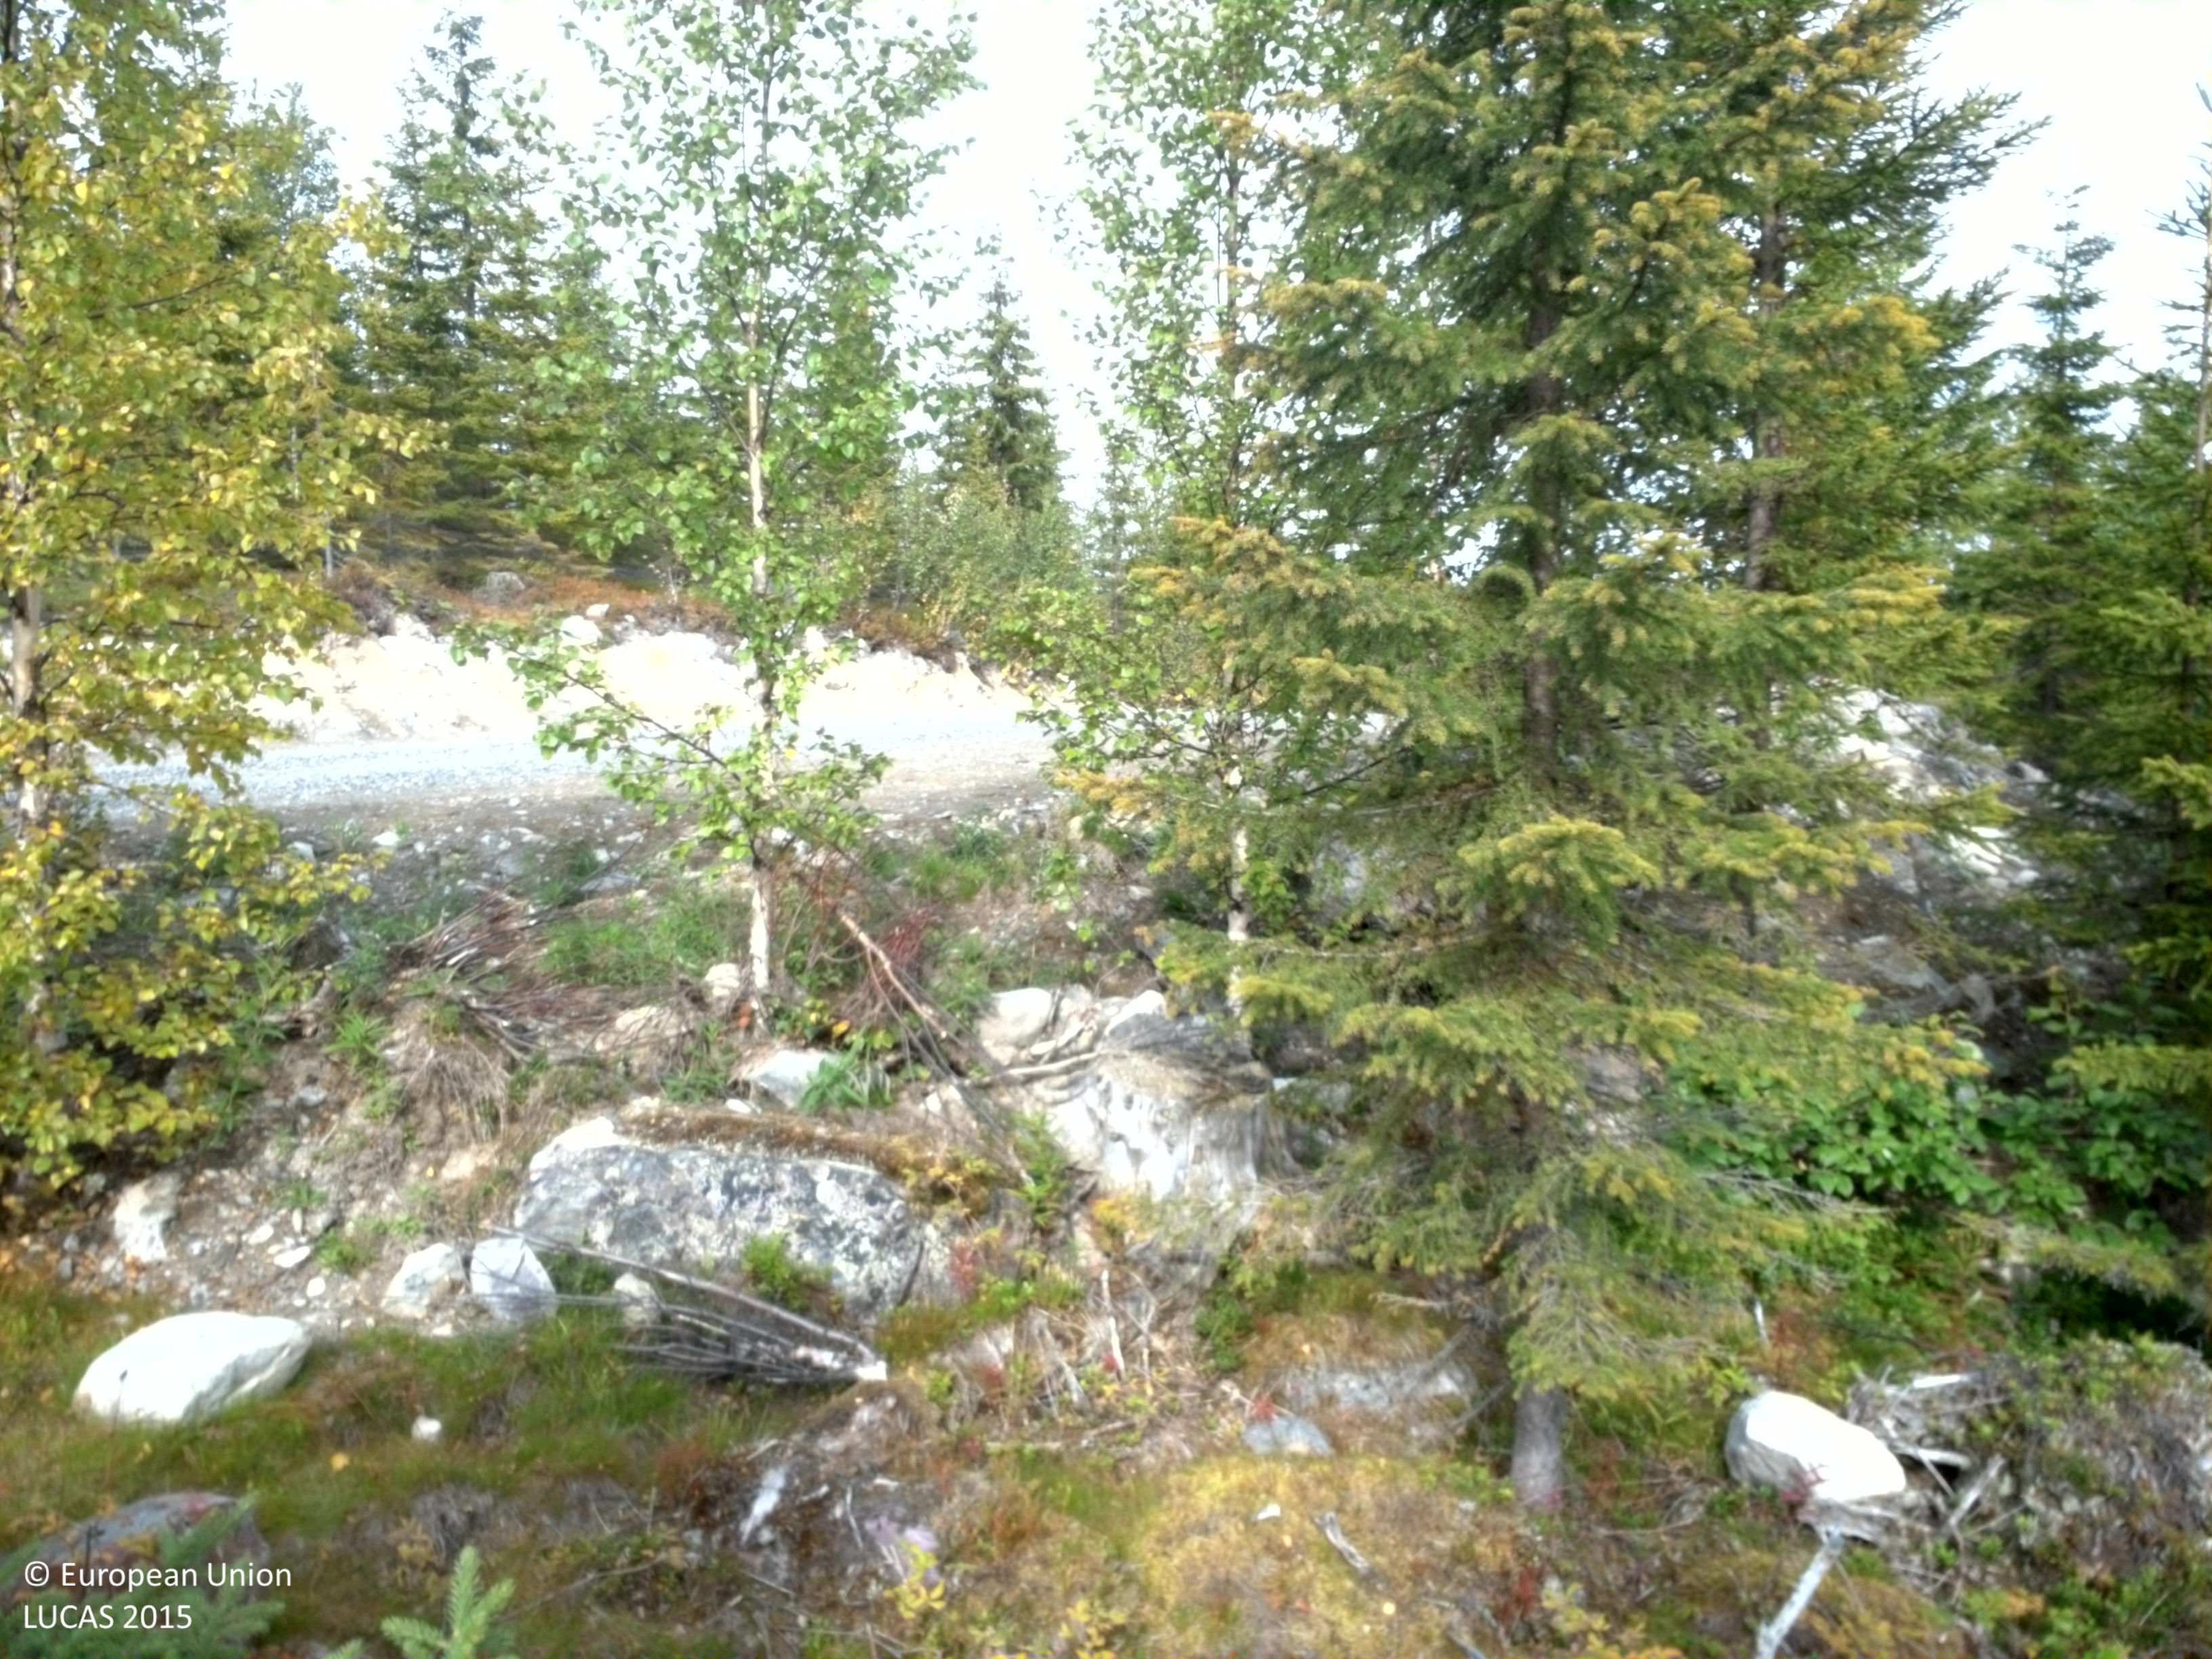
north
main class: Woodland
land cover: Spruce dominated mixed woodland
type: boreal forest
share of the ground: 10 - 25 %
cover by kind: herbaceous plants 35 %, shrubs 25 %, lichens and mosses 20 %, coniferous forest trees 15 %, broadleaved forest trees 5 %
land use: Forestry
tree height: > 5 m
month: September
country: SE
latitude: 65.4011
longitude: 16.6575
